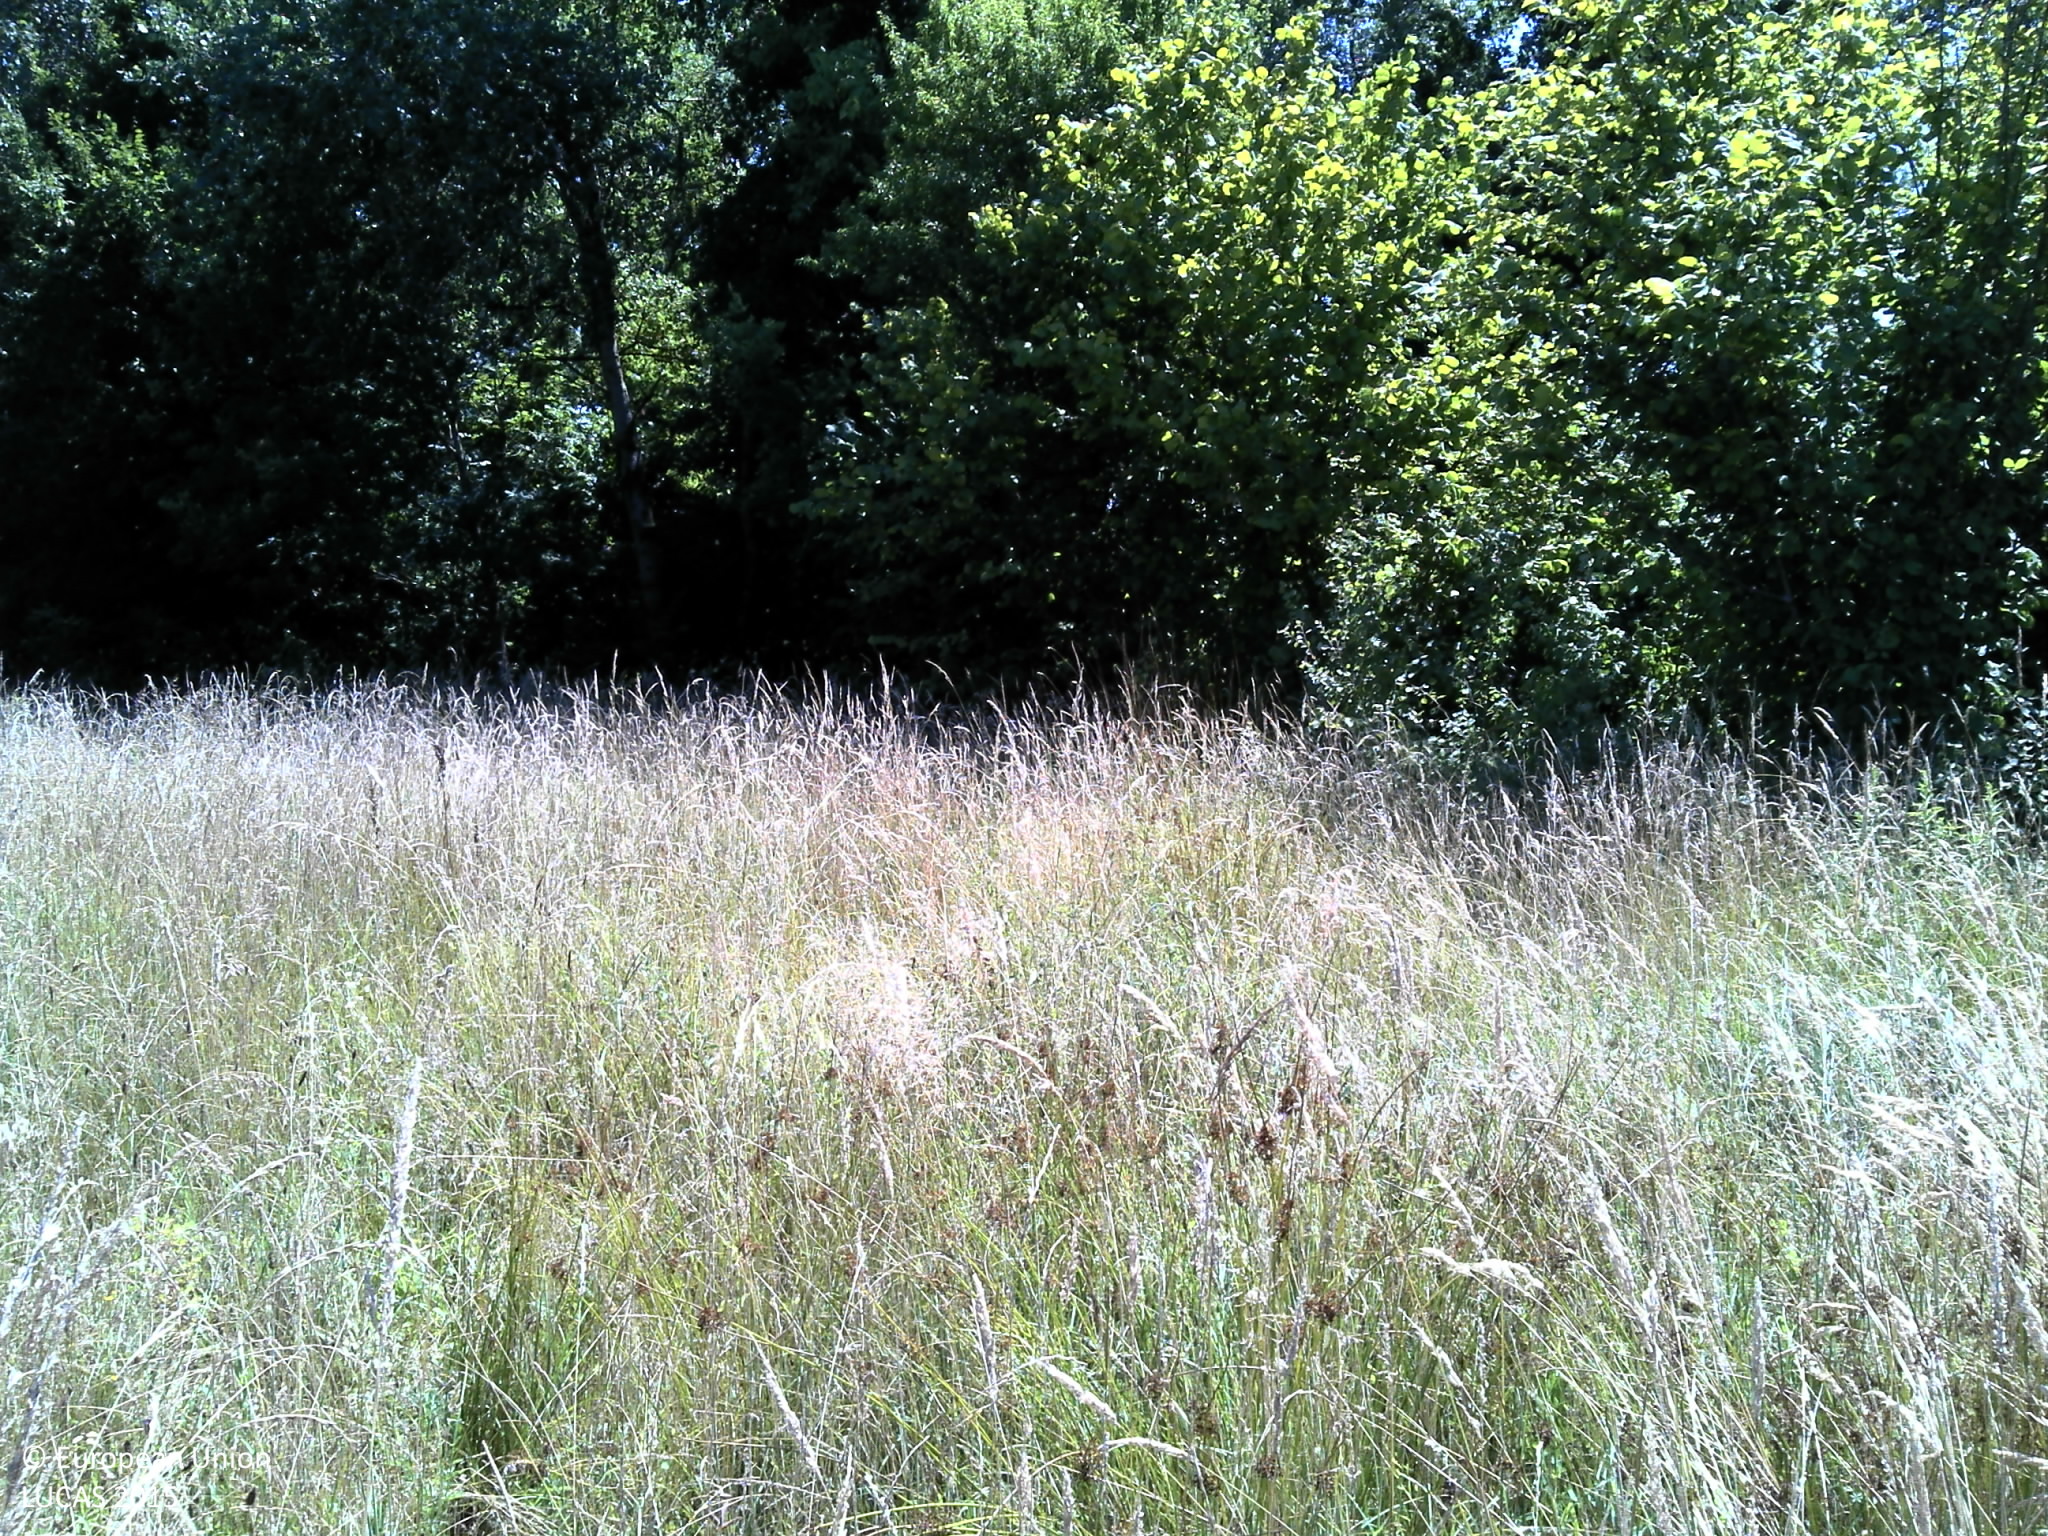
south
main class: Grassland
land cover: Grassland without tree/shrub cover
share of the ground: > 75 %
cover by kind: herbaceous plants 100 %
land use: Semi-natural and natural areas not in use
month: July
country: HR
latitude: 45.4273
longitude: 16.8368
